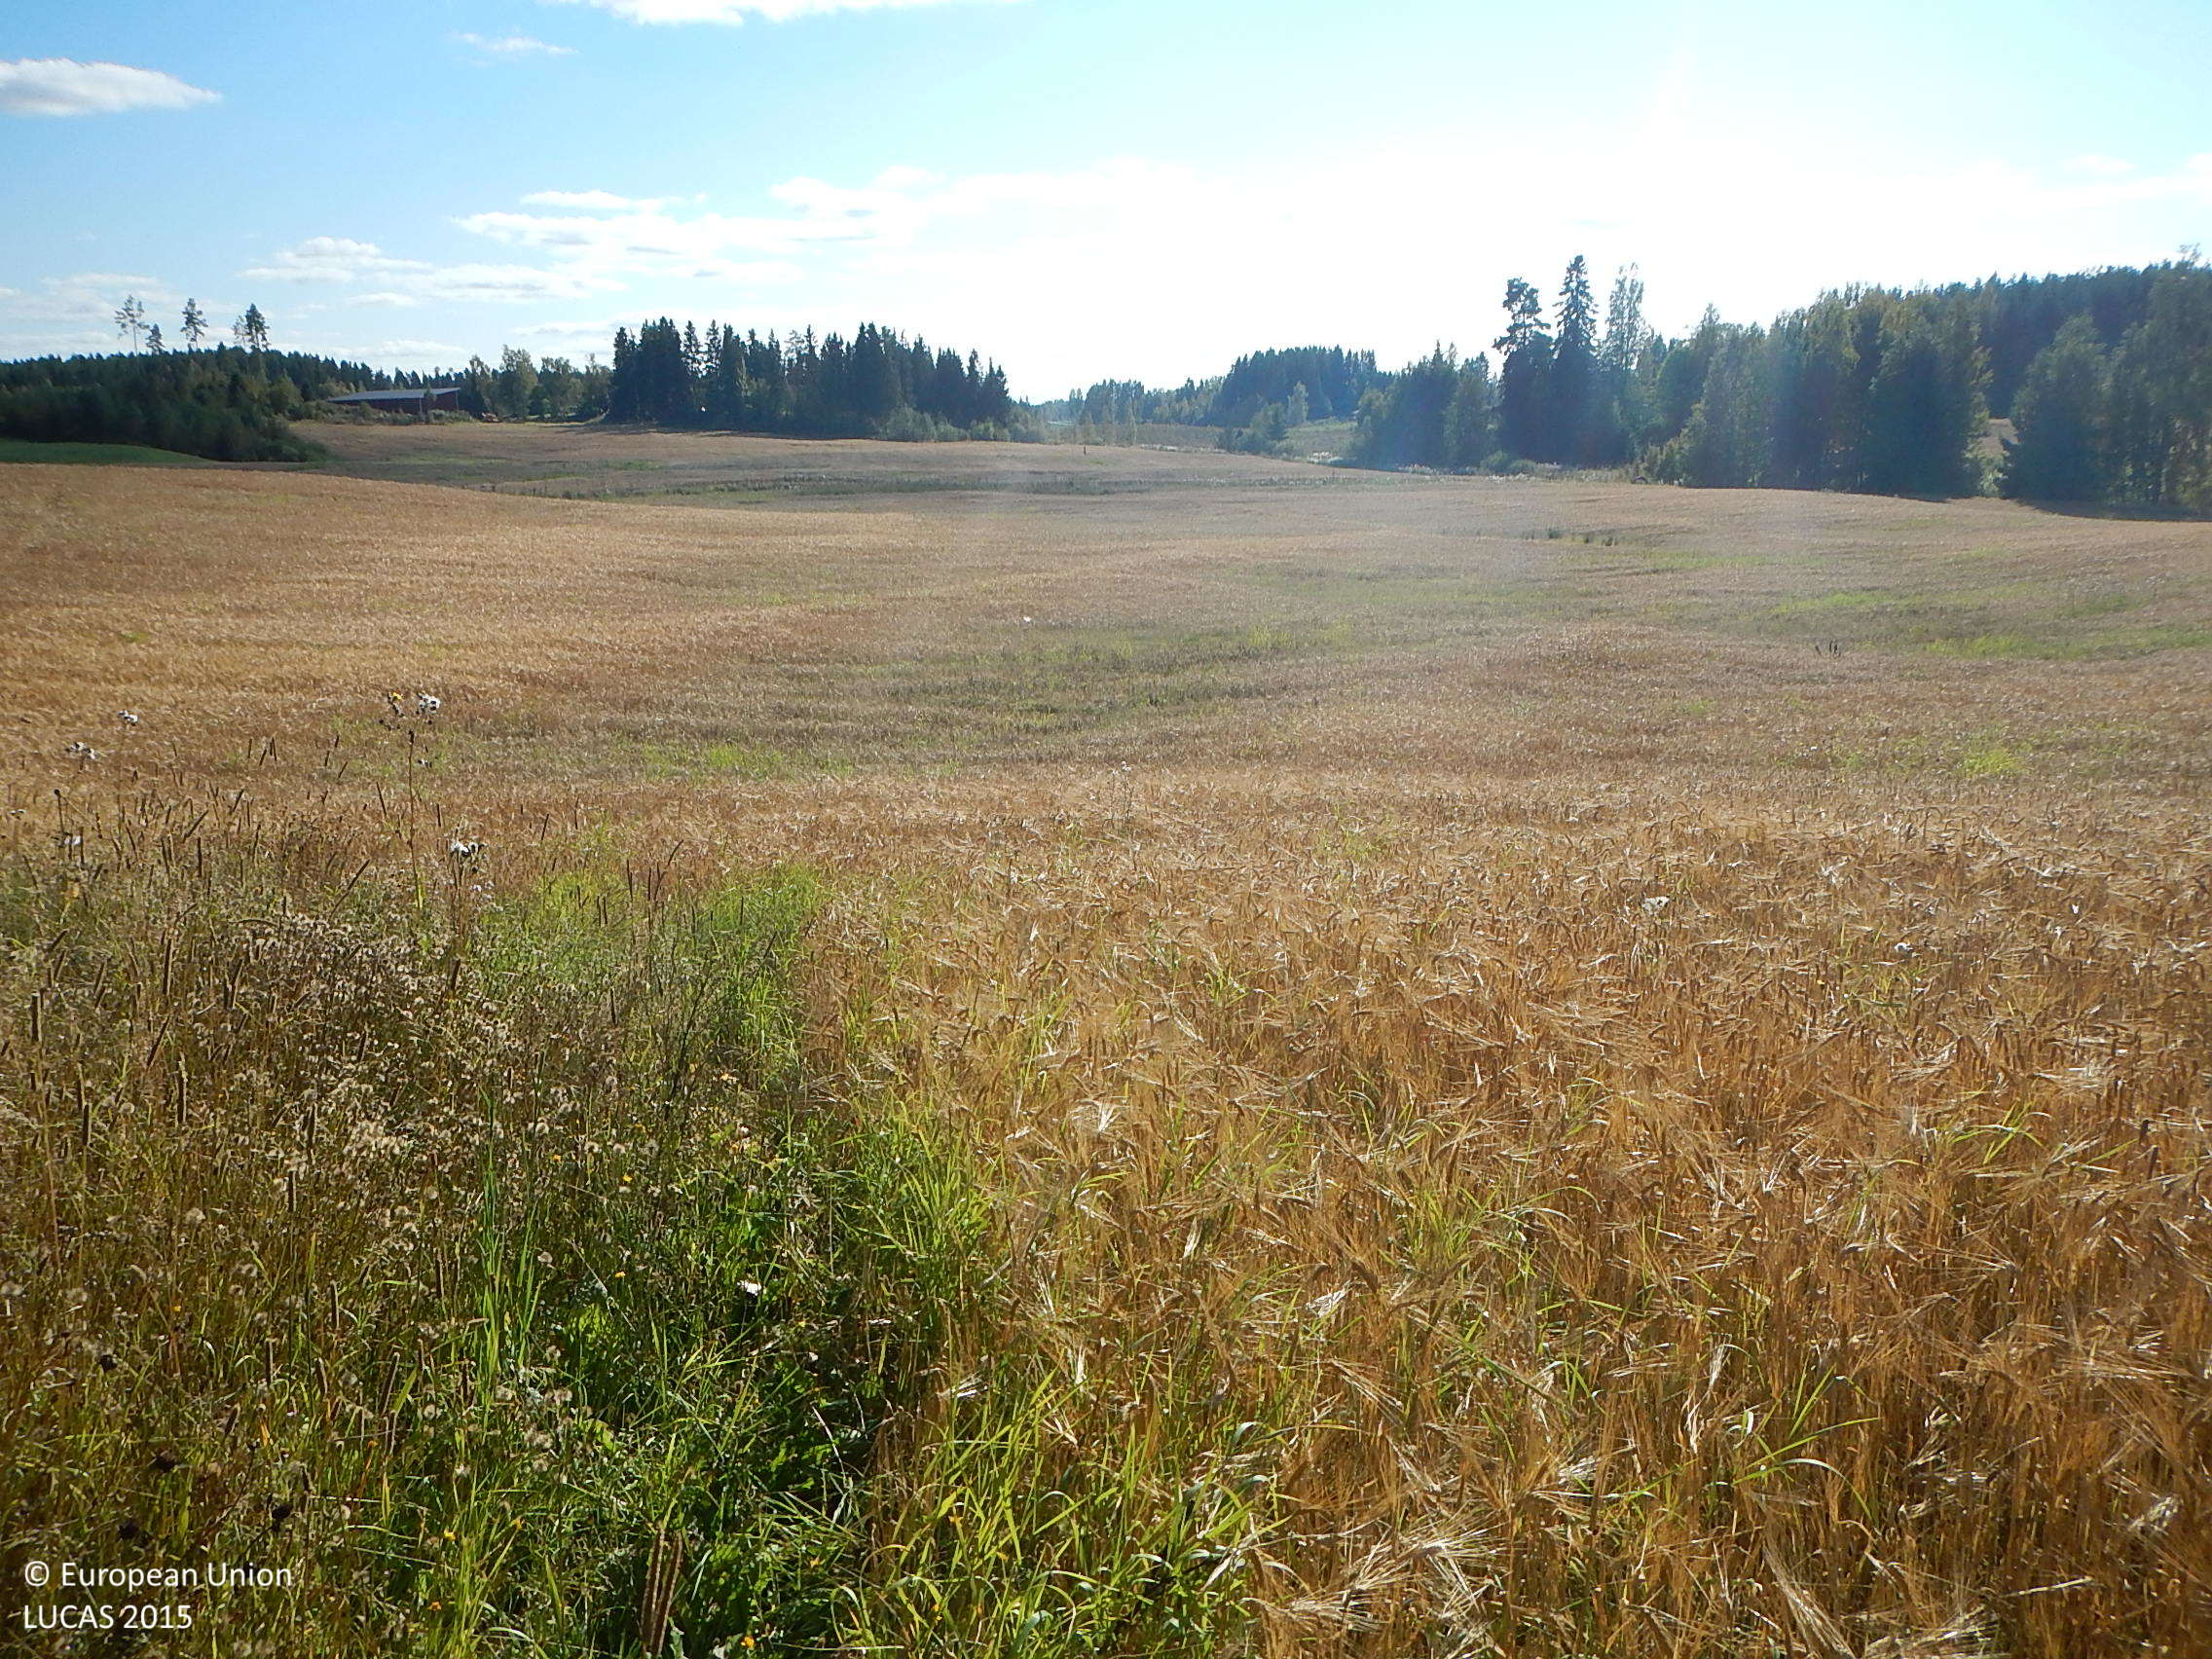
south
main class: Cropland
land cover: Barley
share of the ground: > 75 %
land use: Agriculture (excluding fallow land and kitchen gardens)
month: September
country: FI
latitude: 61.5921
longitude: 22.7473
